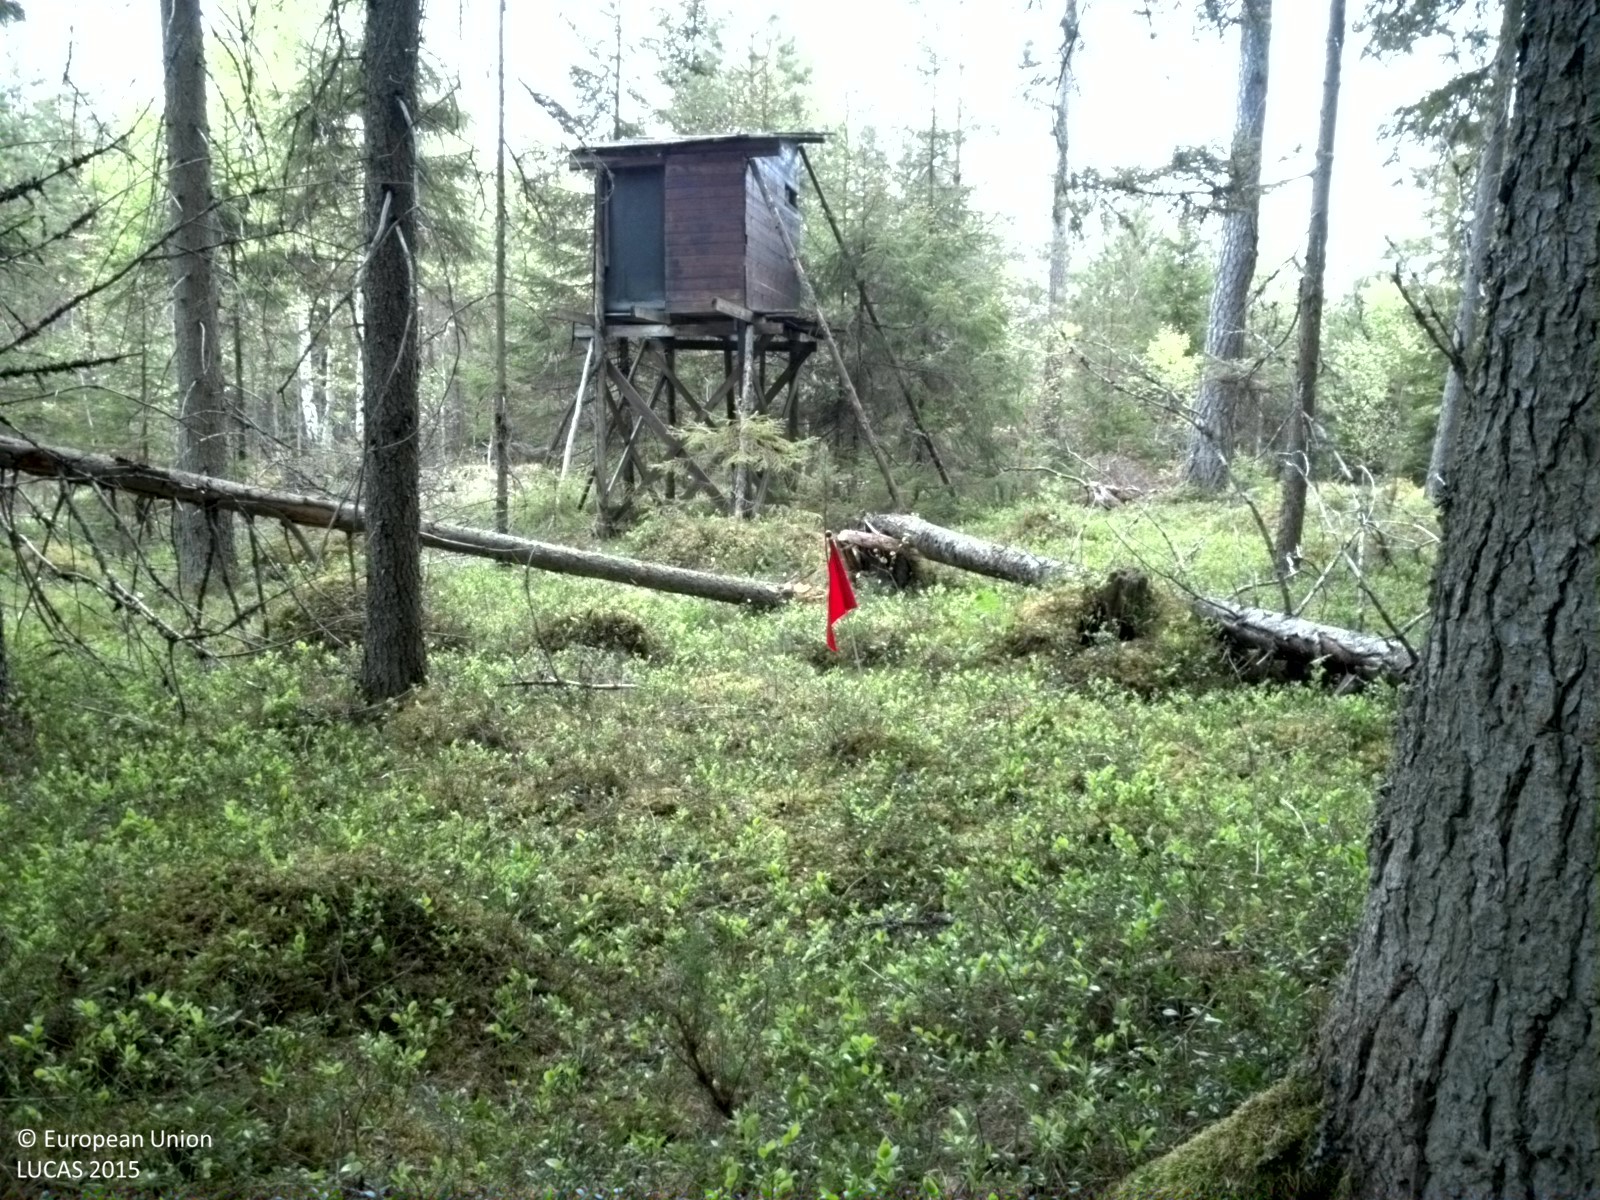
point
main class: Woodland
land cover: Spruce dominated coniferous woodland
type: boreal forest
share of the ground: 50 - 75 %
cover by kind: coniferous forest trees 70 %, shrubs 15 %, lichens and mosses 10 %, herbaceous plants 5 %
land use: Forestry
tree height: > 5 m
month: May
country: SE
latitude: 60.2698
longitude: 18.4745
